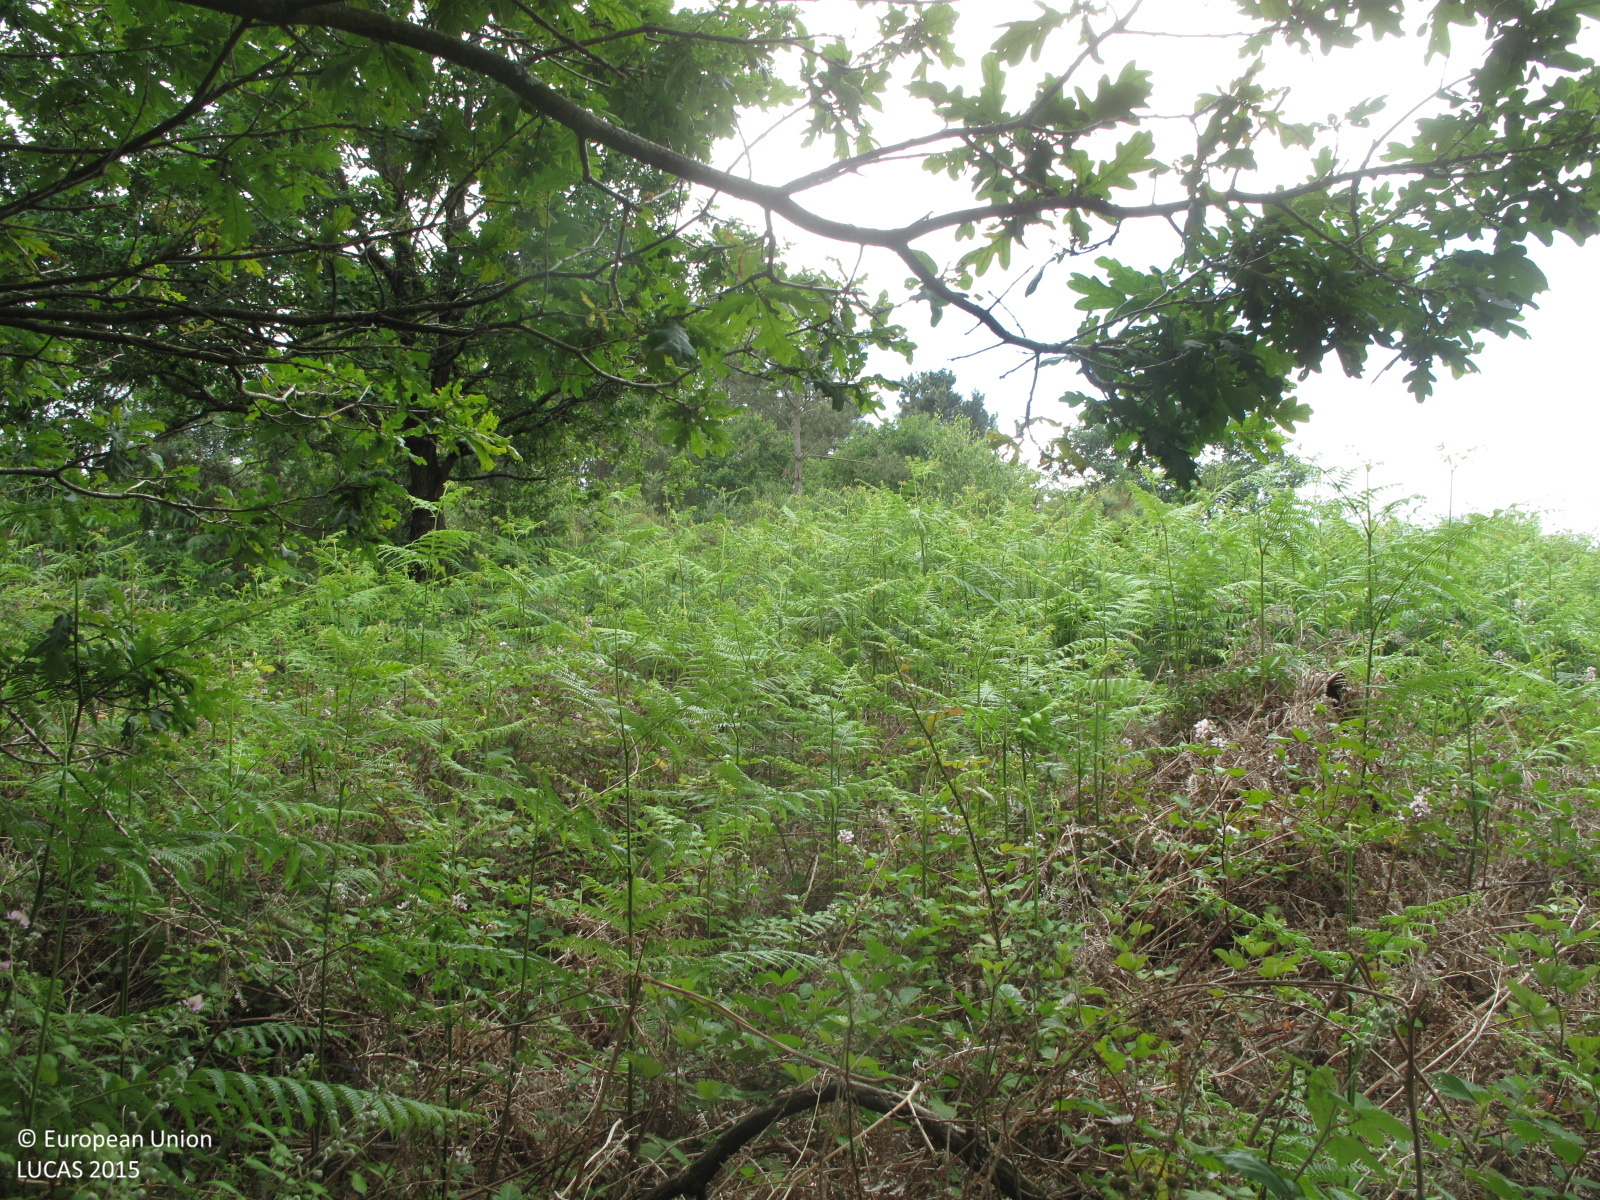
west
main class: Woodland
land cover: Broadleaved woodland
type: acidophilous oak and oak-birch forest
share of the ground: 50 - 75 %
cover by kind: broadleaved forest trees 60 %, shrubs 30 %, herbaceous plants 10 %
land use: Semi-natural and natural areas not in use
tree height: > 5 m
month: June
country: ES
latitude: 43.0943
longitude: -8.4977
